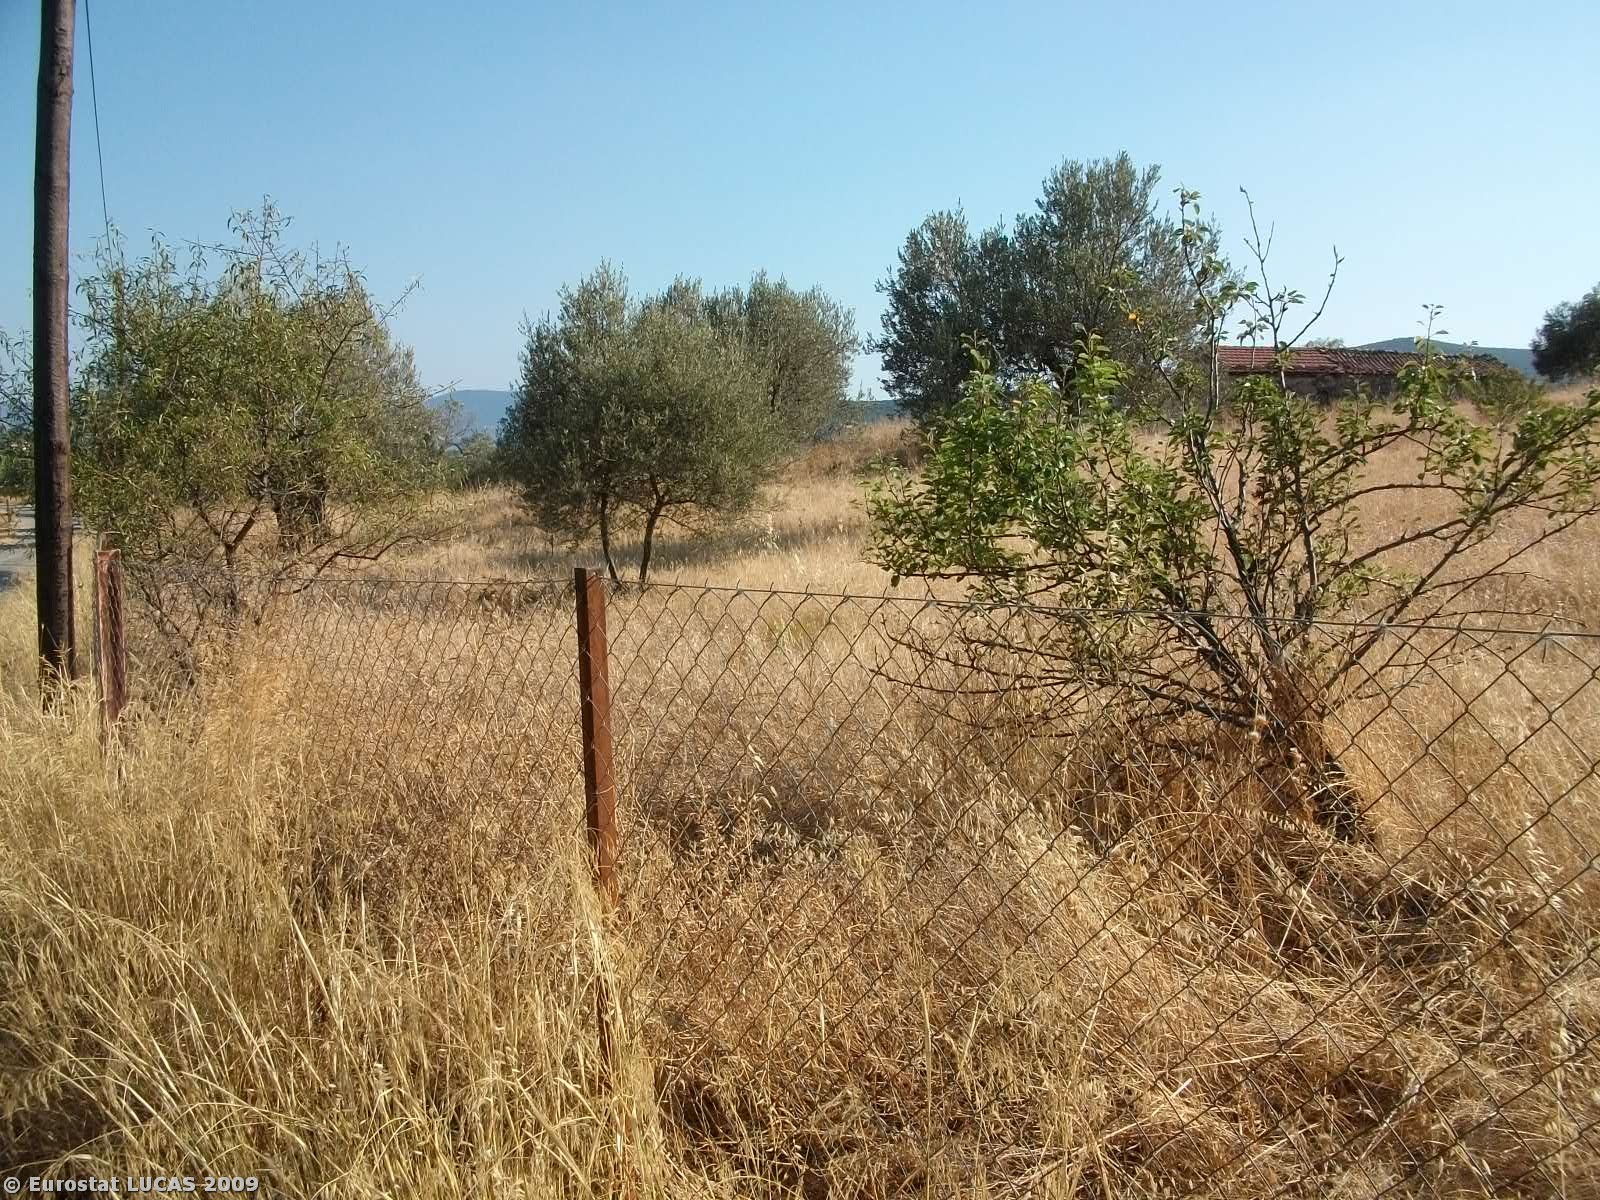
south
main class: Cropland
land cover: Olive groves
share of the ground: 25 - 50 %
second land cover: Grassland with sparse tree/shrub cover
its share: > 75 %
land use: Agriculture (excluding fallow land and kitchen gardens)
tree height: < 5 m
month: August
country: GR
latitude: 37.4128
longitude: 23.3112
